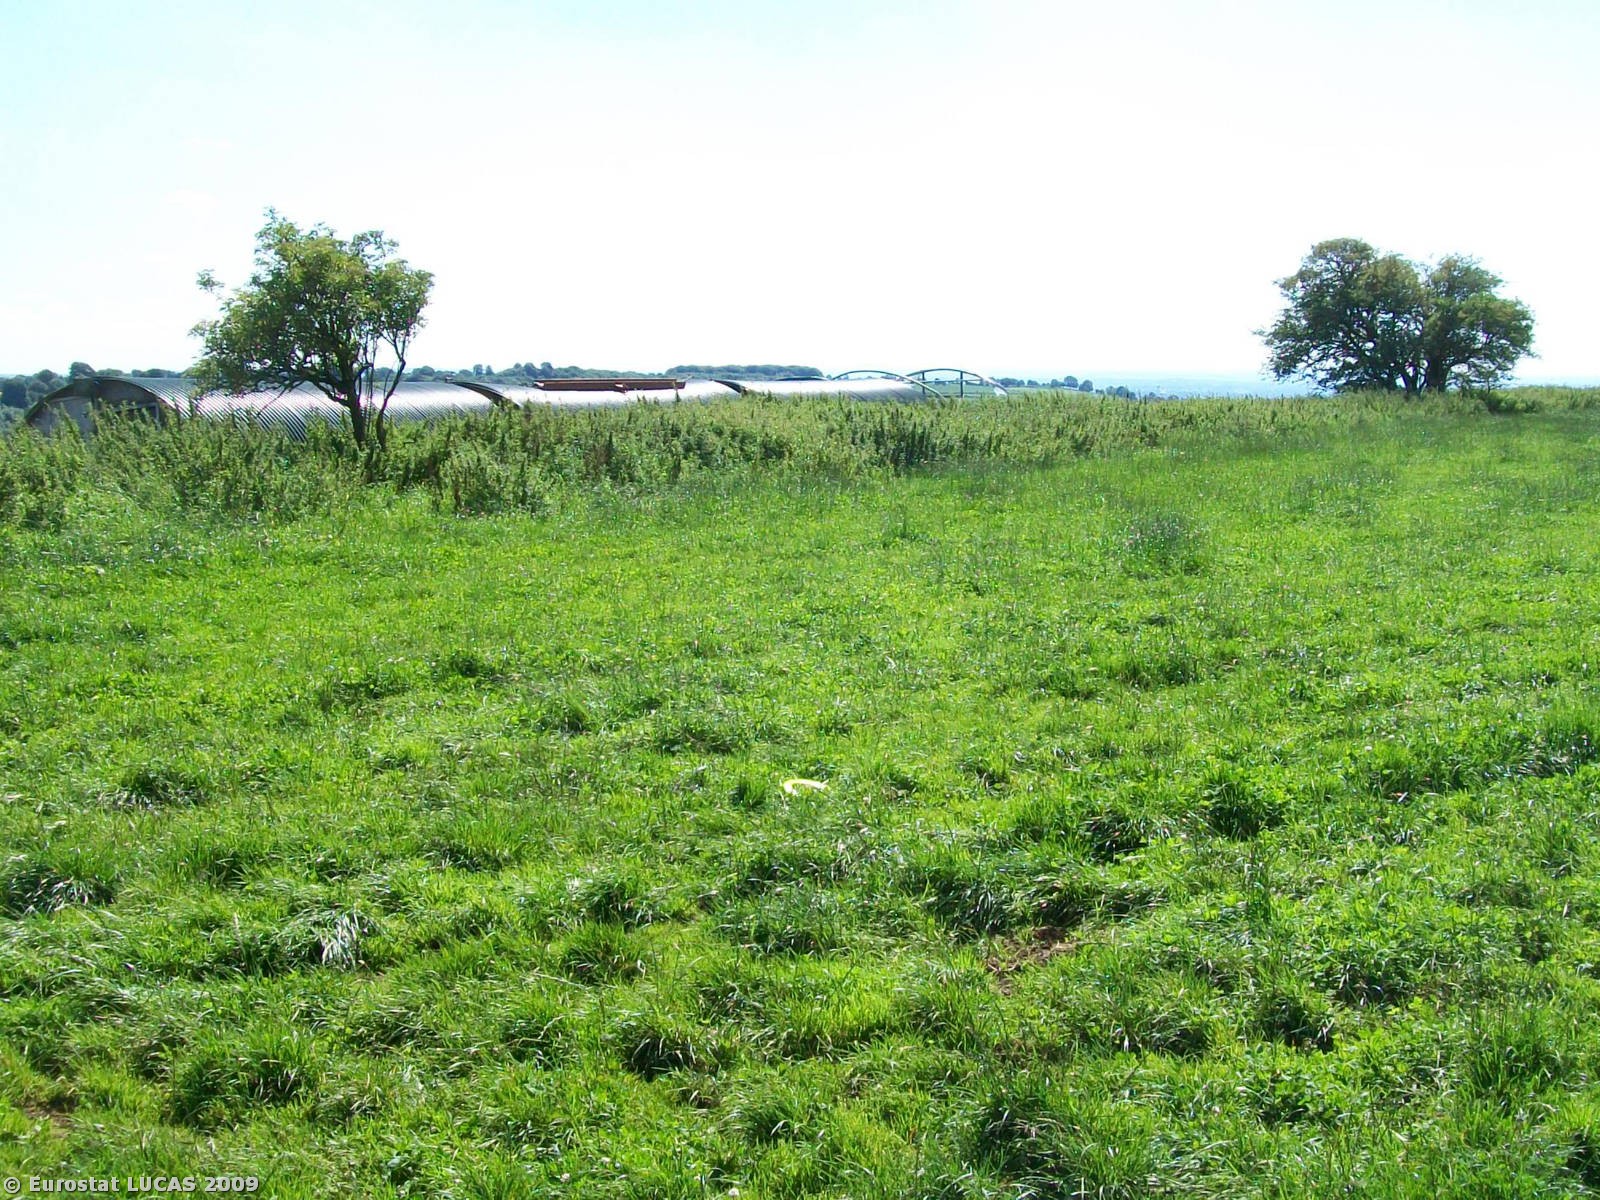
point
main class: Grassland
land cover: Grassland without tree/shrub cover
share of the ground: > 75 %
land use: Agriculture (excluding fallow land and kitchen gardens)
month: August
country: GB
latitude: 51.6612
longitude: -2.3081
